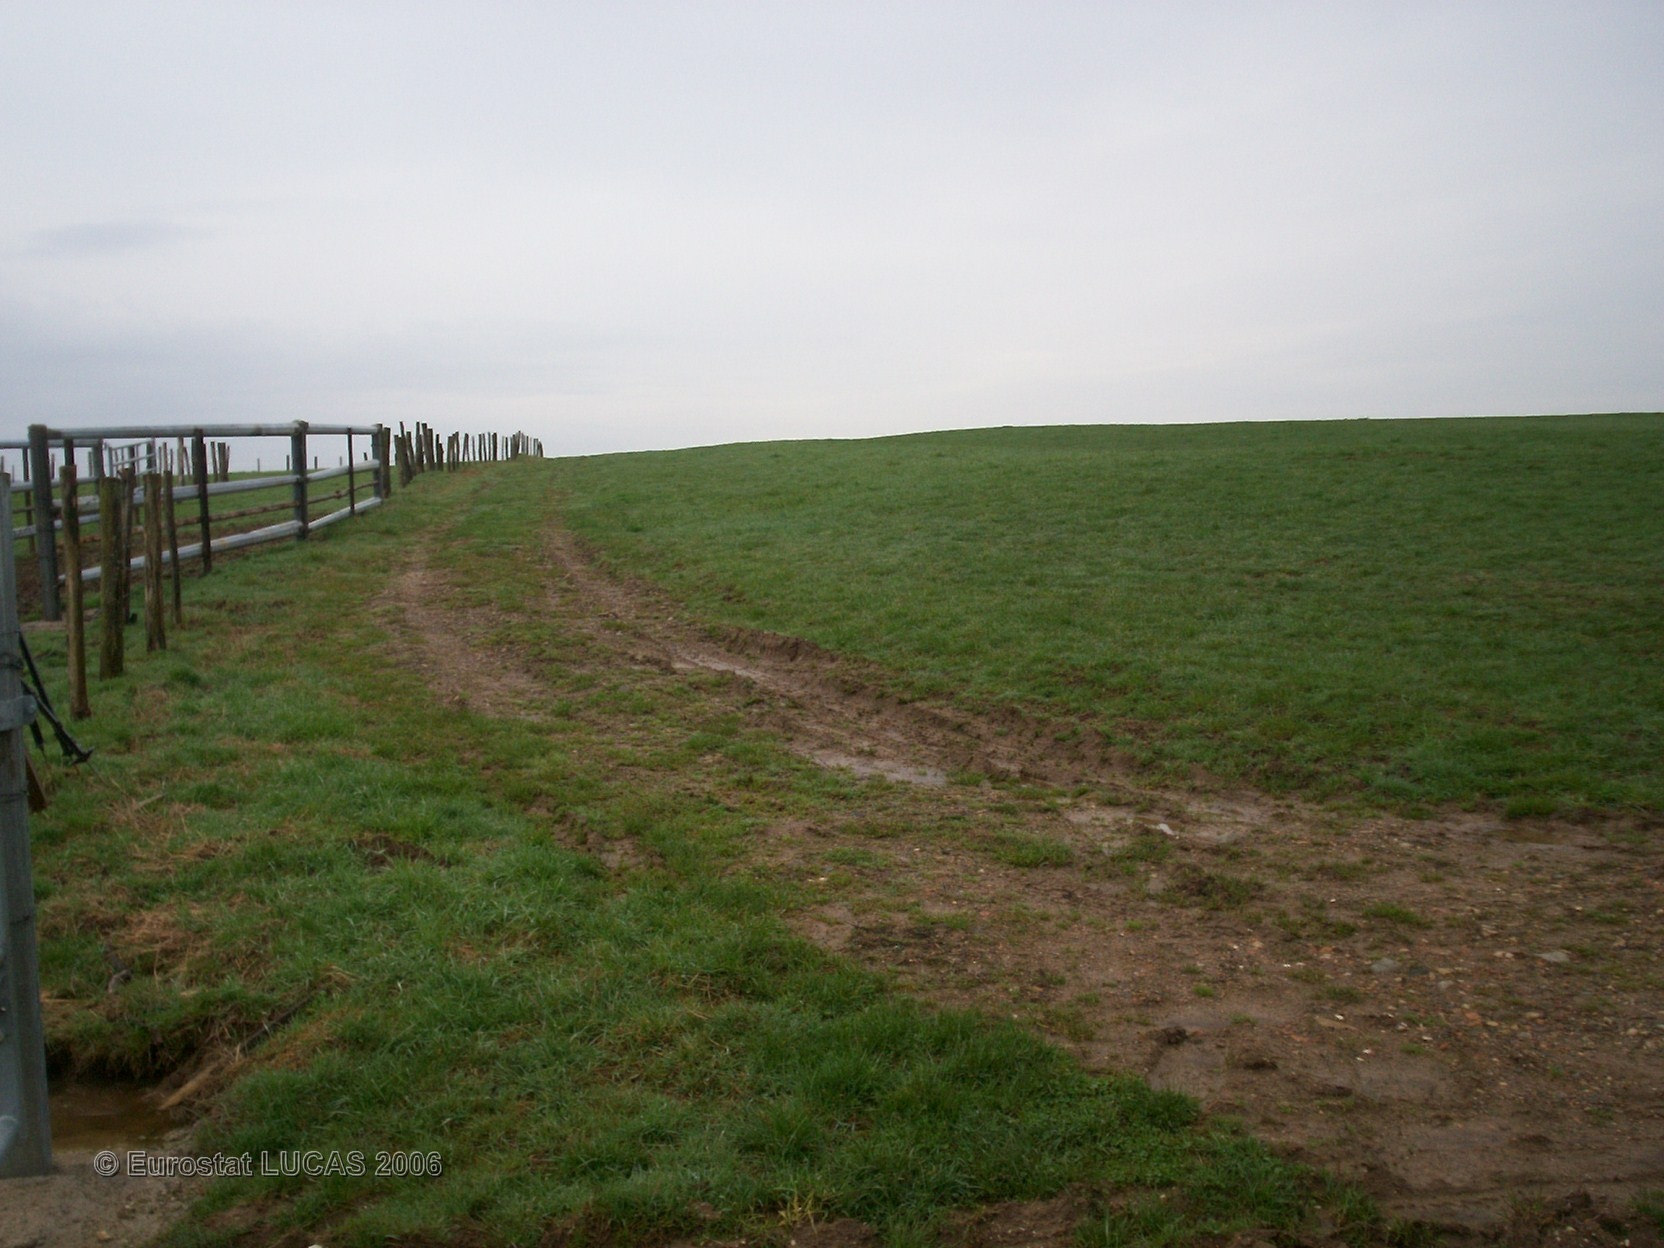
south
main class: Grassland
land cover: Grassland without tree/shrub cover
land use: Agriculture (excluding fallow land and kitchen gardens)
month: April
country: FR
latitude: 47.6366
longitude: 6.7939
